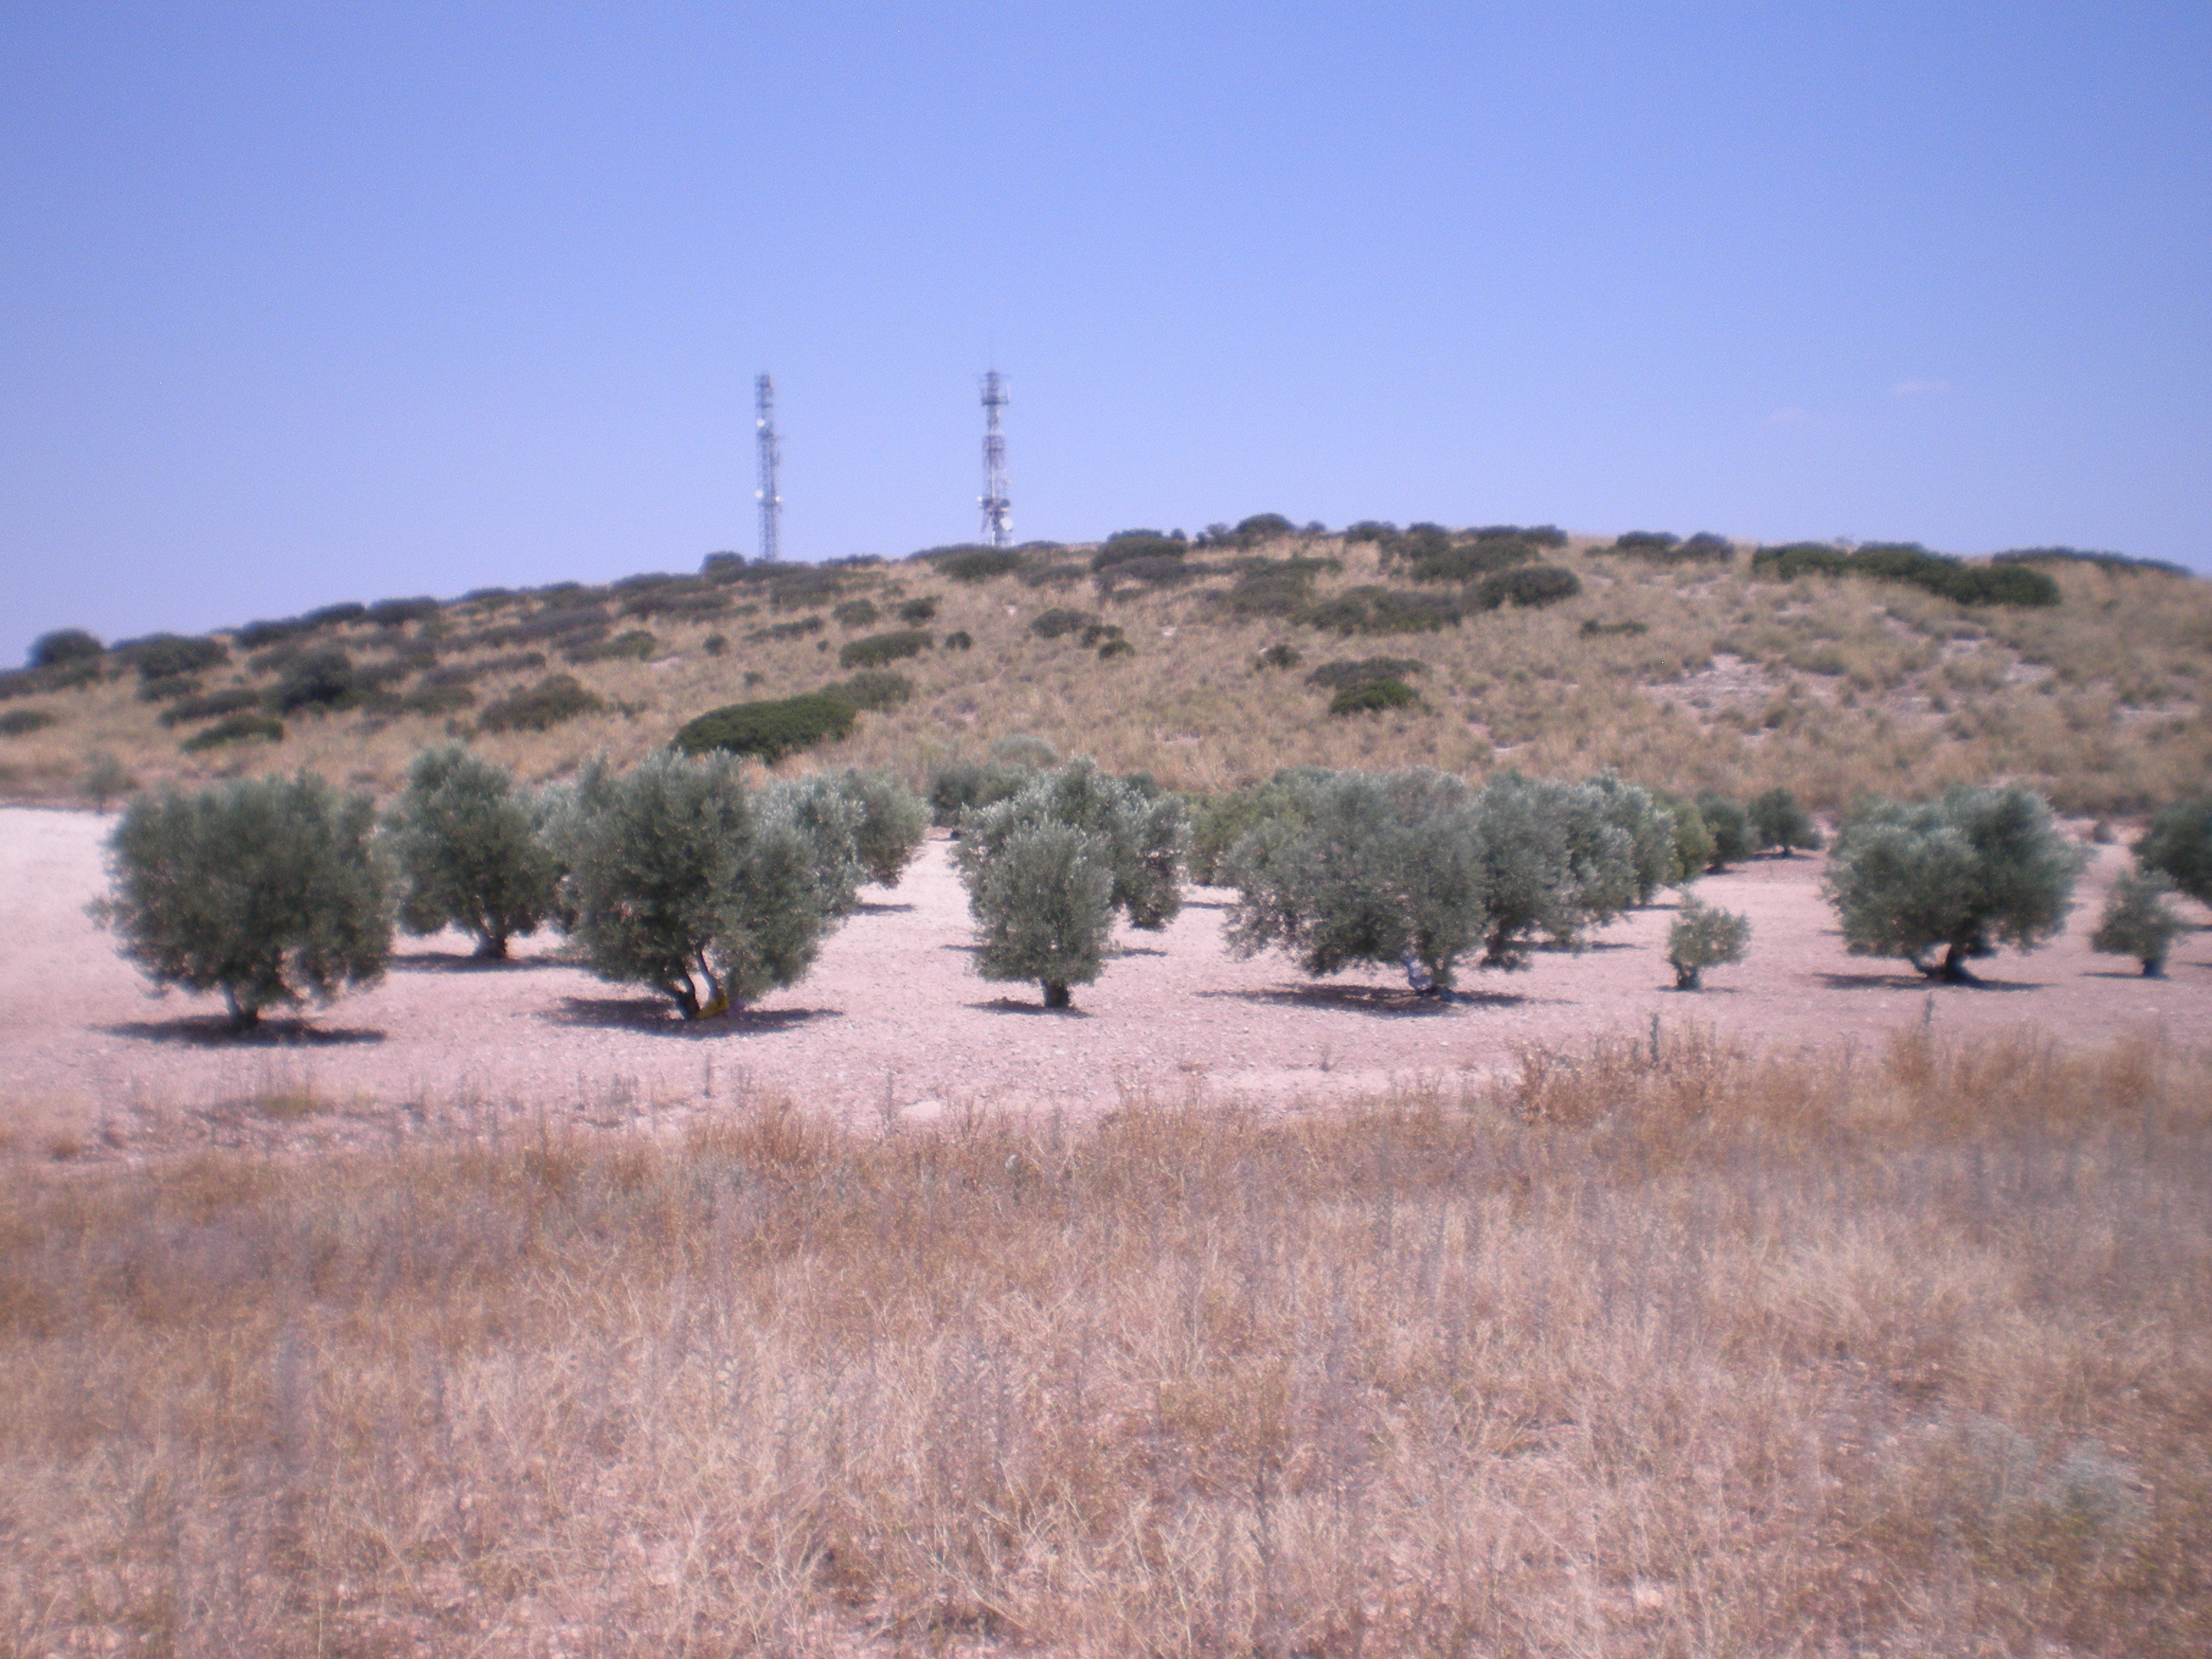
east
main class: Grassland
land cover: Spontaneously vegetated surfaces
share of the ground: 25 - 50 %
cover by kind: unconsolidated bare surface 70 %, herbaceous plants 30 %
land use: Abandoned areas
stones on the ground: < 10 %
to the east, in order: Spontaneously vegetated surfaces; Grass margins; Tracks; Grass margins; Olive groves; Grass margins; Tracks; Grass margins; Olive groves; Grassland without tree/shrub cover; Grassland with sparse tree/shrub cover; Rock outcrops; Grassland without tree/shrub cover
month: June
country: ES
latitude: 39.6236
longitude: -3.3615
